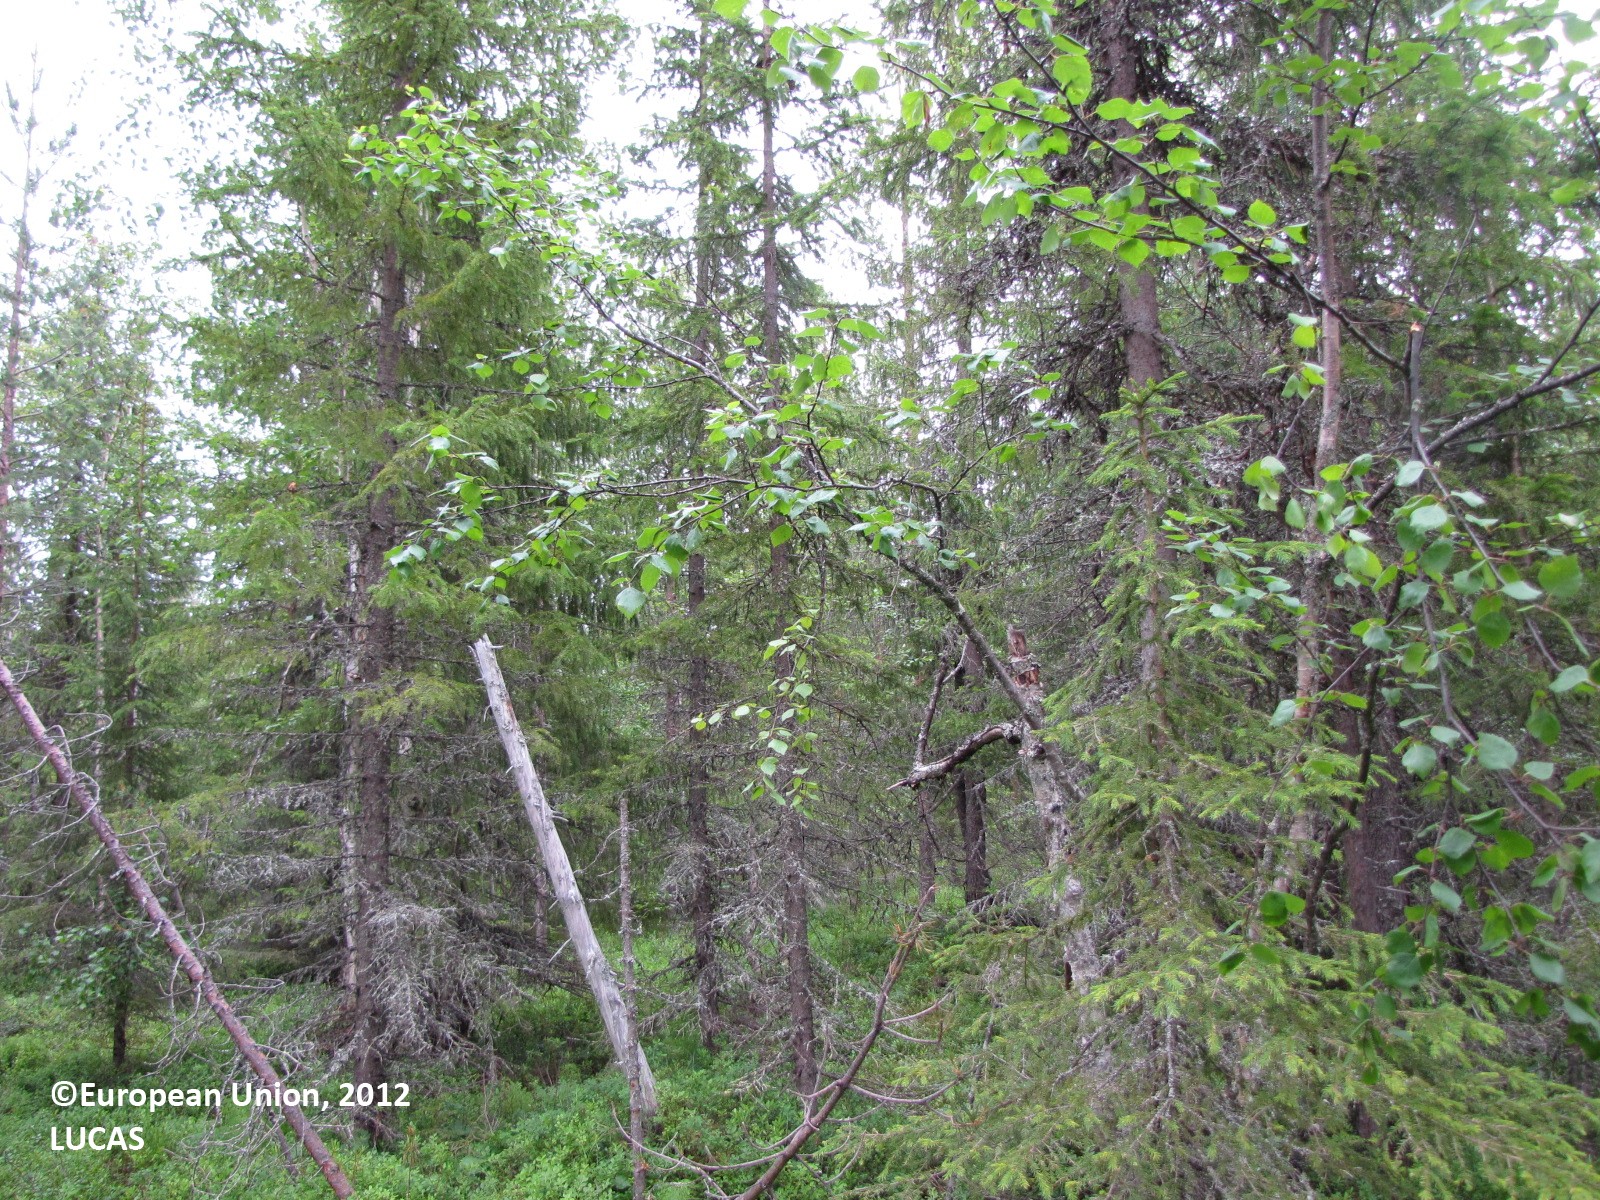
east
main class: Woodland
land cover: Spruce dominated mixed woodland
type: boreal forest
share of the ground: 25 - 50 %
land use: Forestry
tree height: > 5 m
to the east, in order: Spruce dominated mixed woodland; Ditches and canals; Pine dominated coniferous woodland; Ditches and canals; Pine dominated mixed woodland; Ditches and canals; Pine dominated mixed woodland; Pine dominated coniferous woodland; Ditches and canals; Pine dominated coniferous woodland; Ditches and canals; Pine dominated coniferous woodland; Ditches and canals; Pine dominated coniferous woodland; Ditches and canals; Pine dominated coniferous woodland
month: July
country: FI
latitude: 66.5324
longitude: 24.9266
